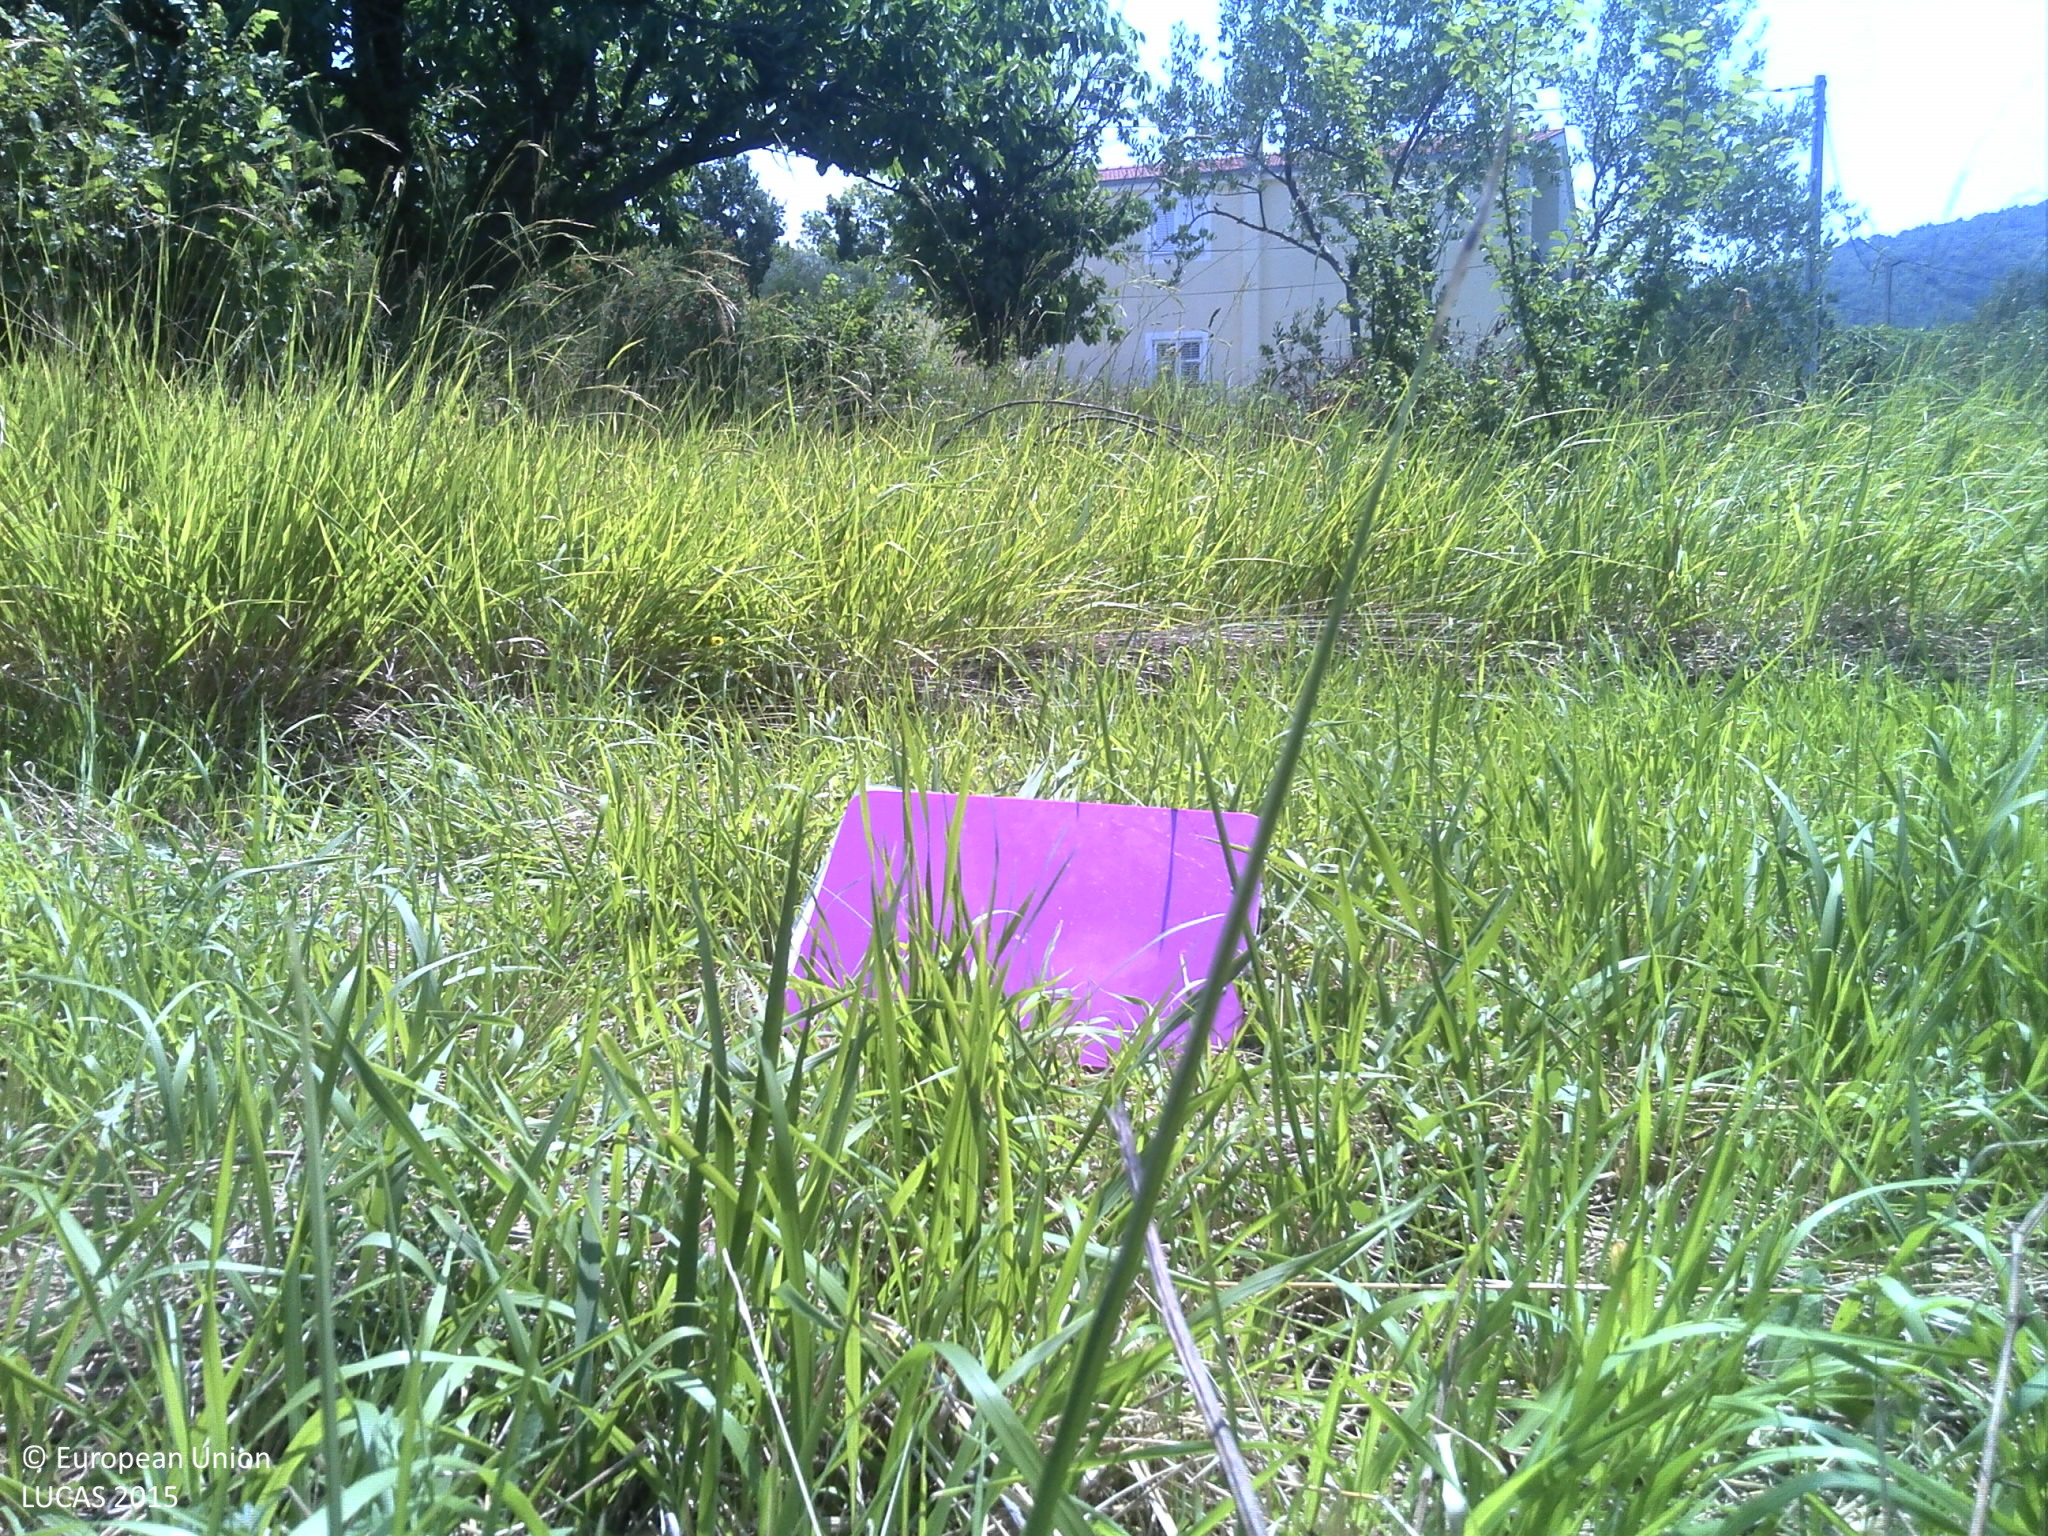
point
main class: Grassland
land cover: Grassland with sparse tree/shrub cover
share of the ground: > 75 %
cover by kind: herbaceous plants 85 %, shrubs 10 %, broadleaved forest trees 5 %
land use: Agriculture (excluding fallow land and kitchen gardens)
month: June
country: HR
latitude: 43.4885
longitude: 16.6063
